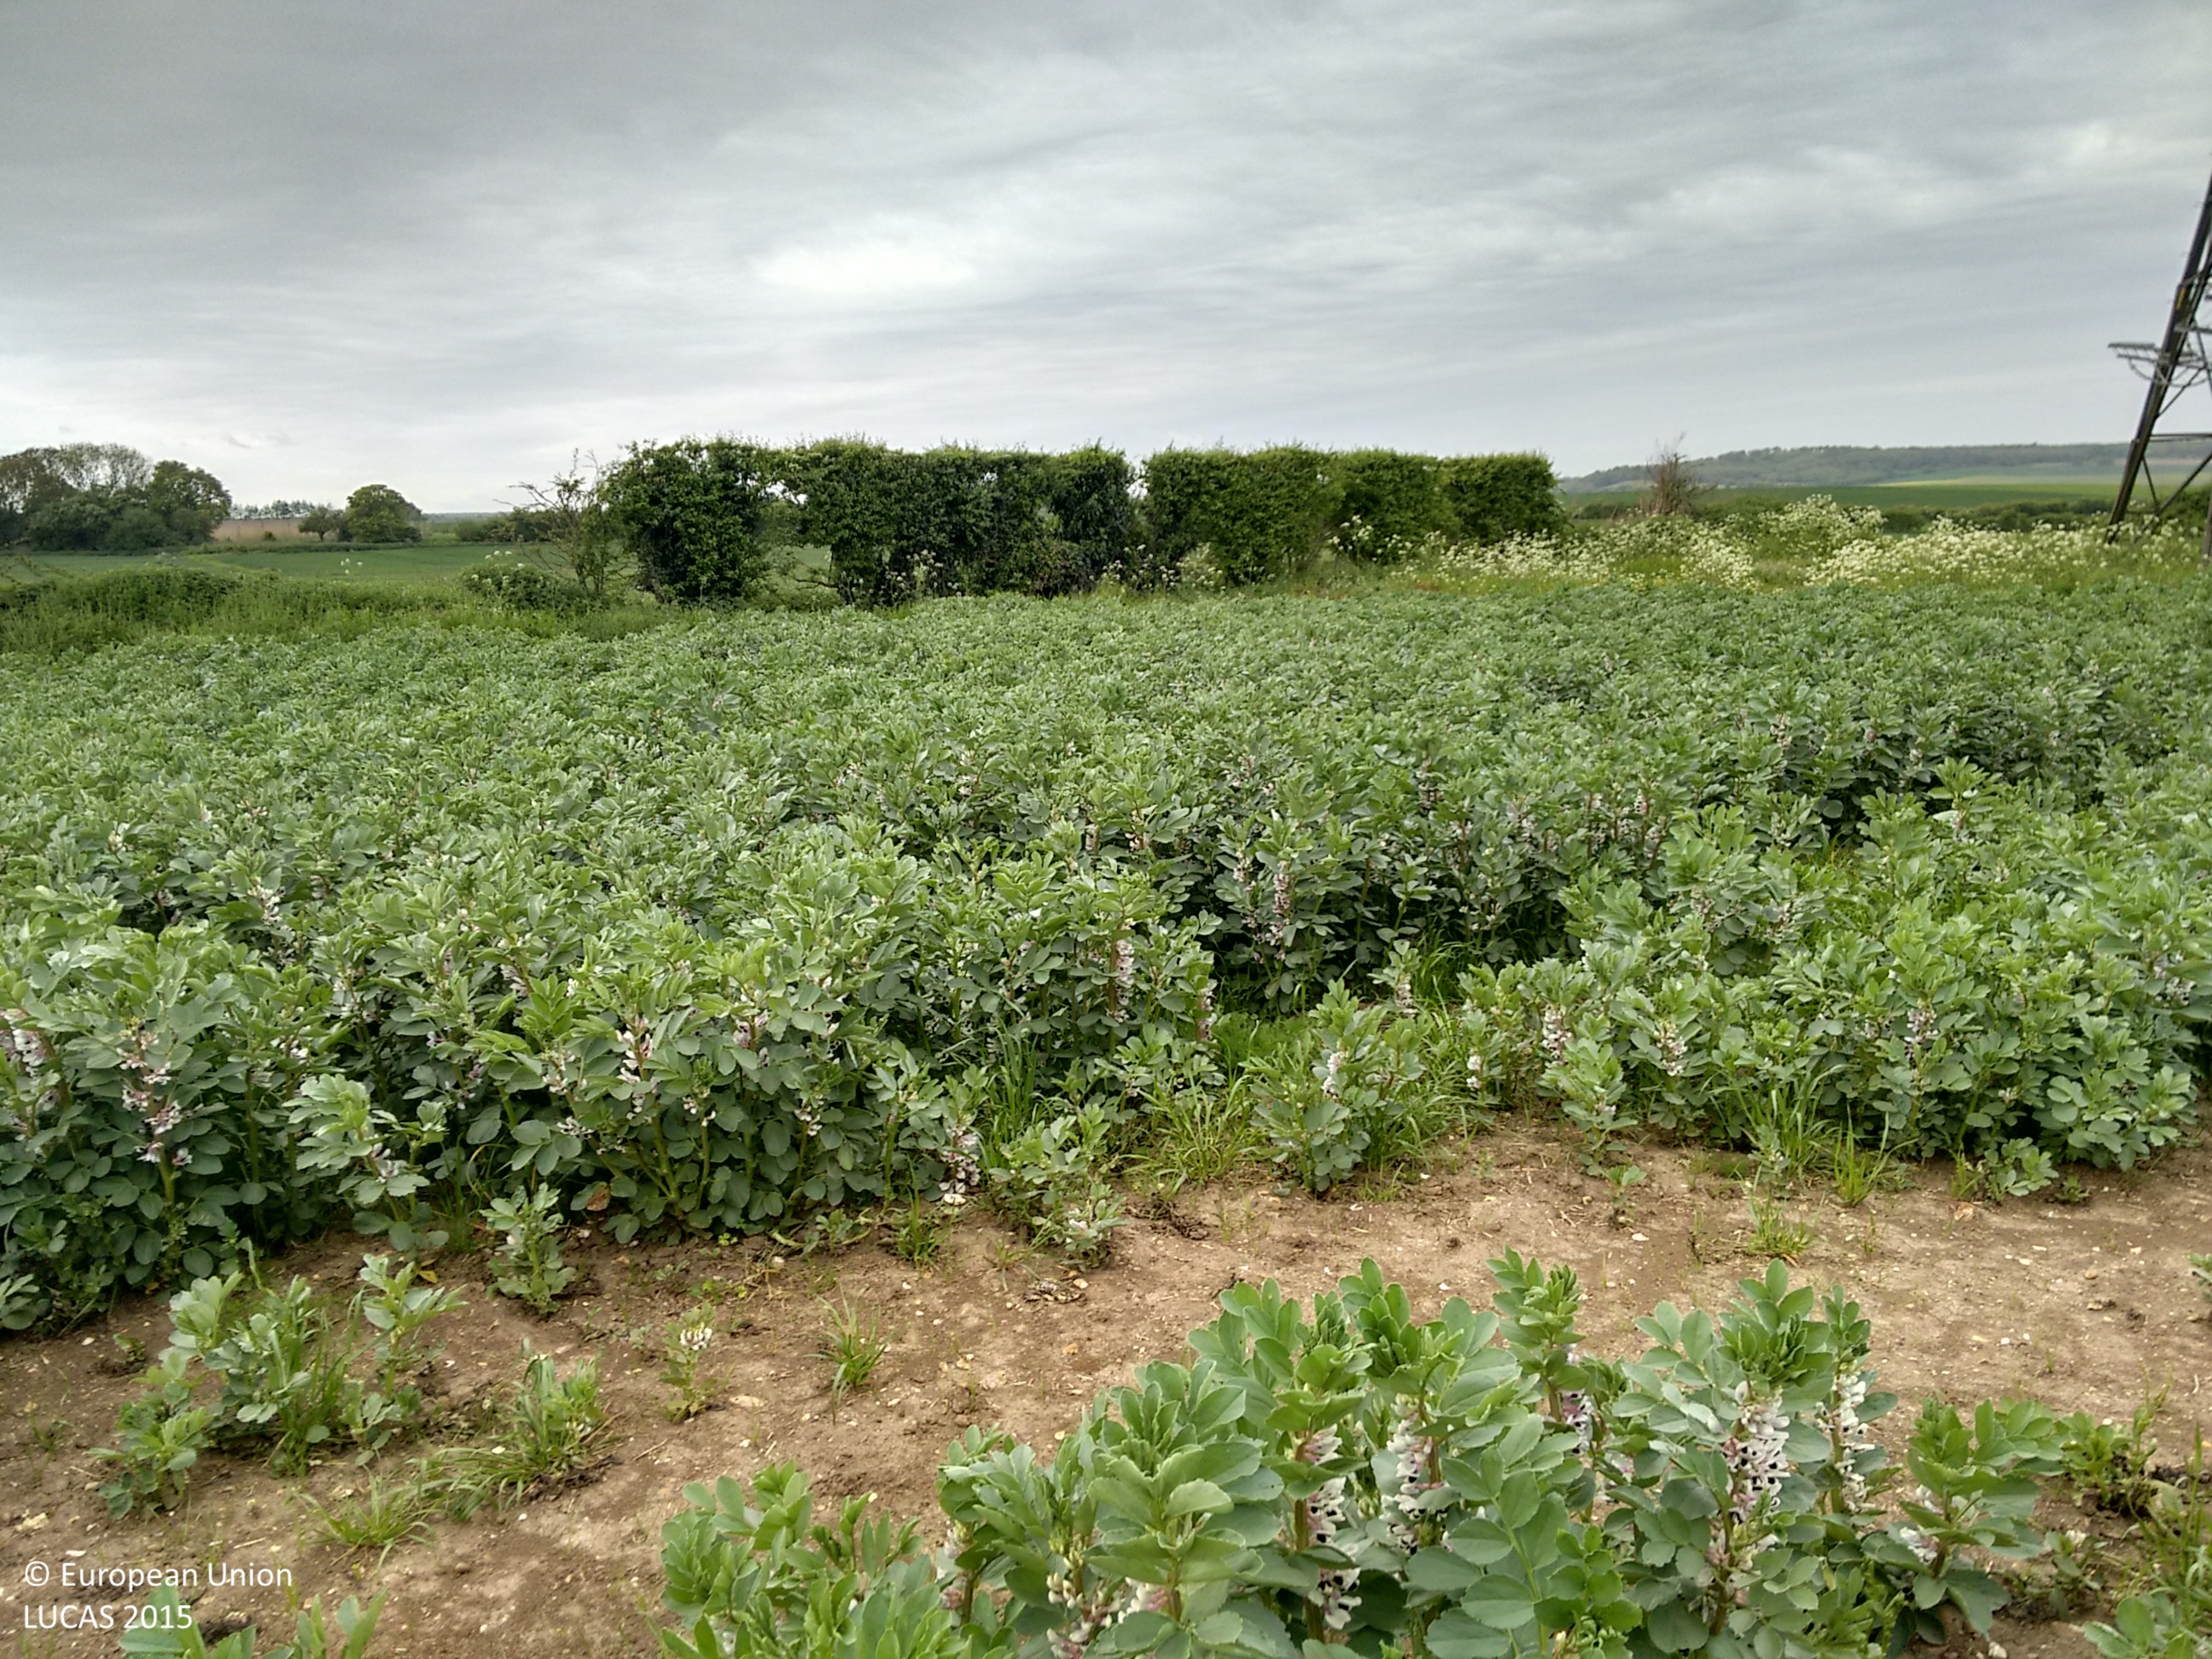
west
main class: Cropland
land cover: Dry pulses
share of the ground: > 75 %
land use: Agriculture (excluding fallow land and kitchen gardens)
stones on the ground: 10 - 25 %
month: May
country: GB
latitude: 51.3972
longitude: 0.2680
